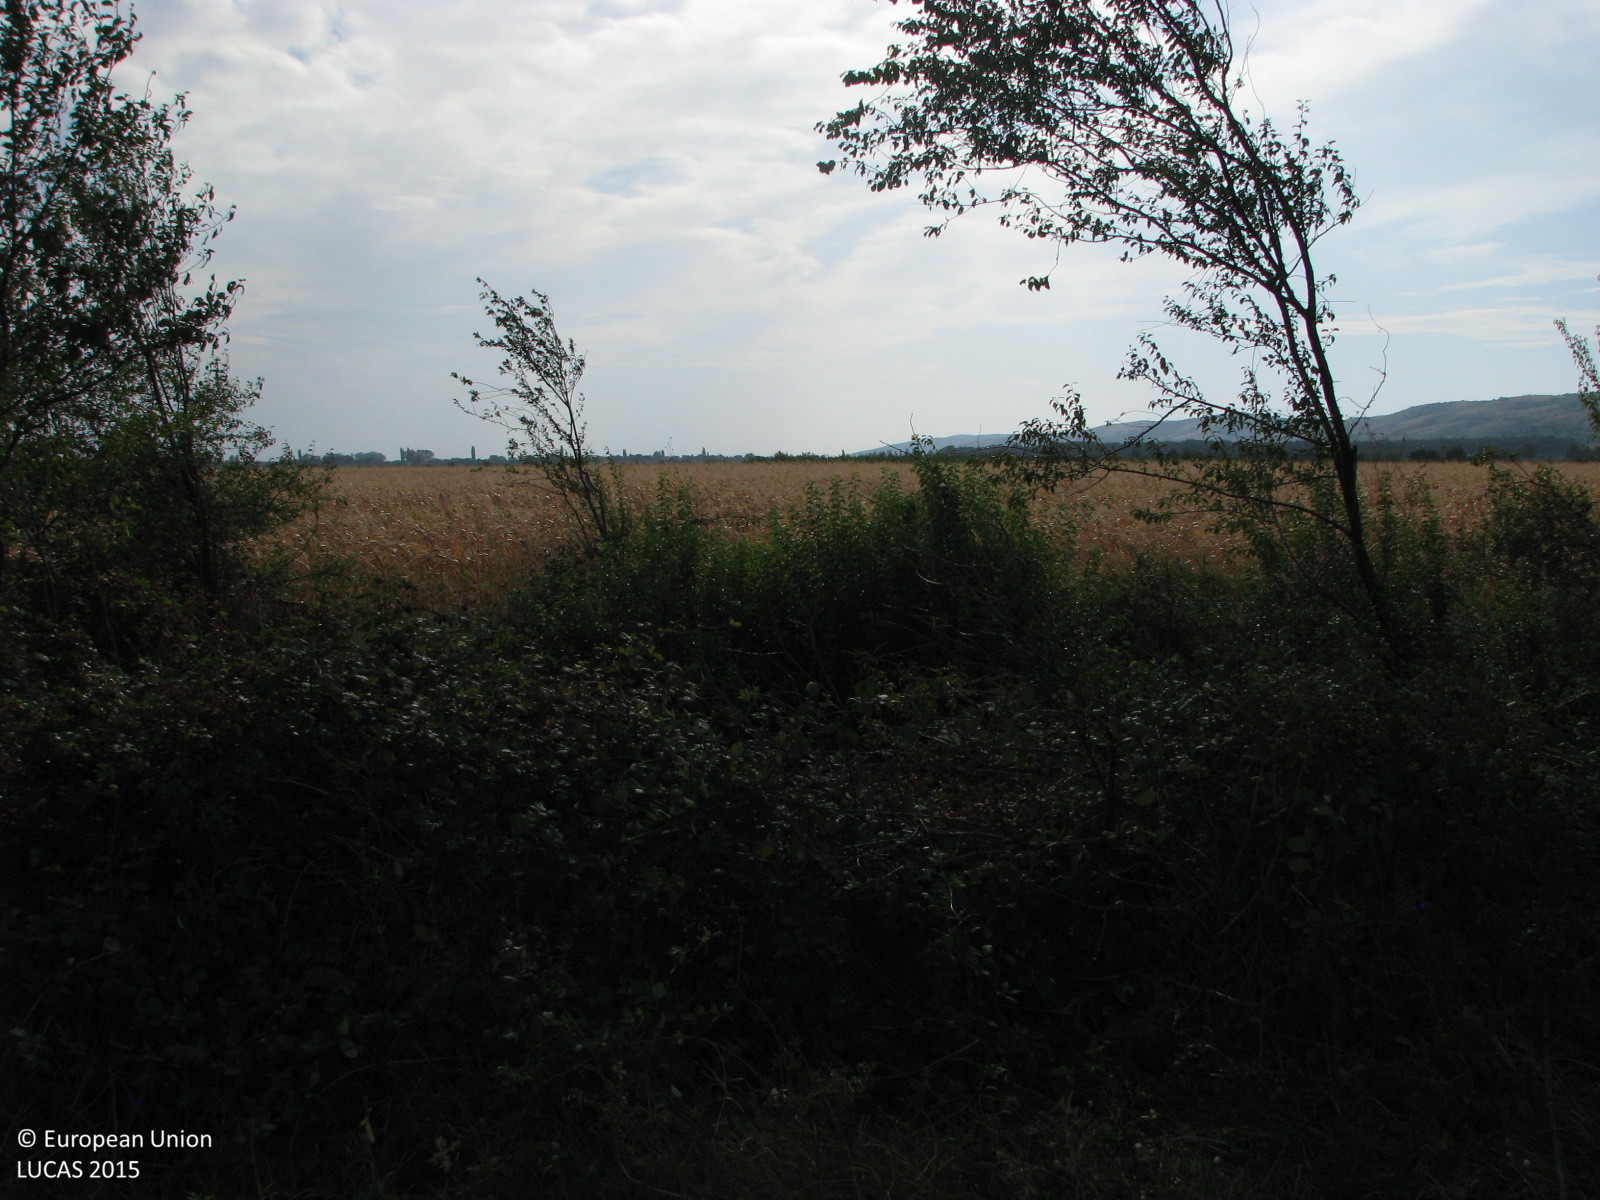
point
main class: Cropland
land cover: Maize
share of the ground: > 75 %
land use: Agriculture (excluding fallow land and kitchen gardens)
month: September
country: BG
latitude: 42.5211
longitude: 25.9407
